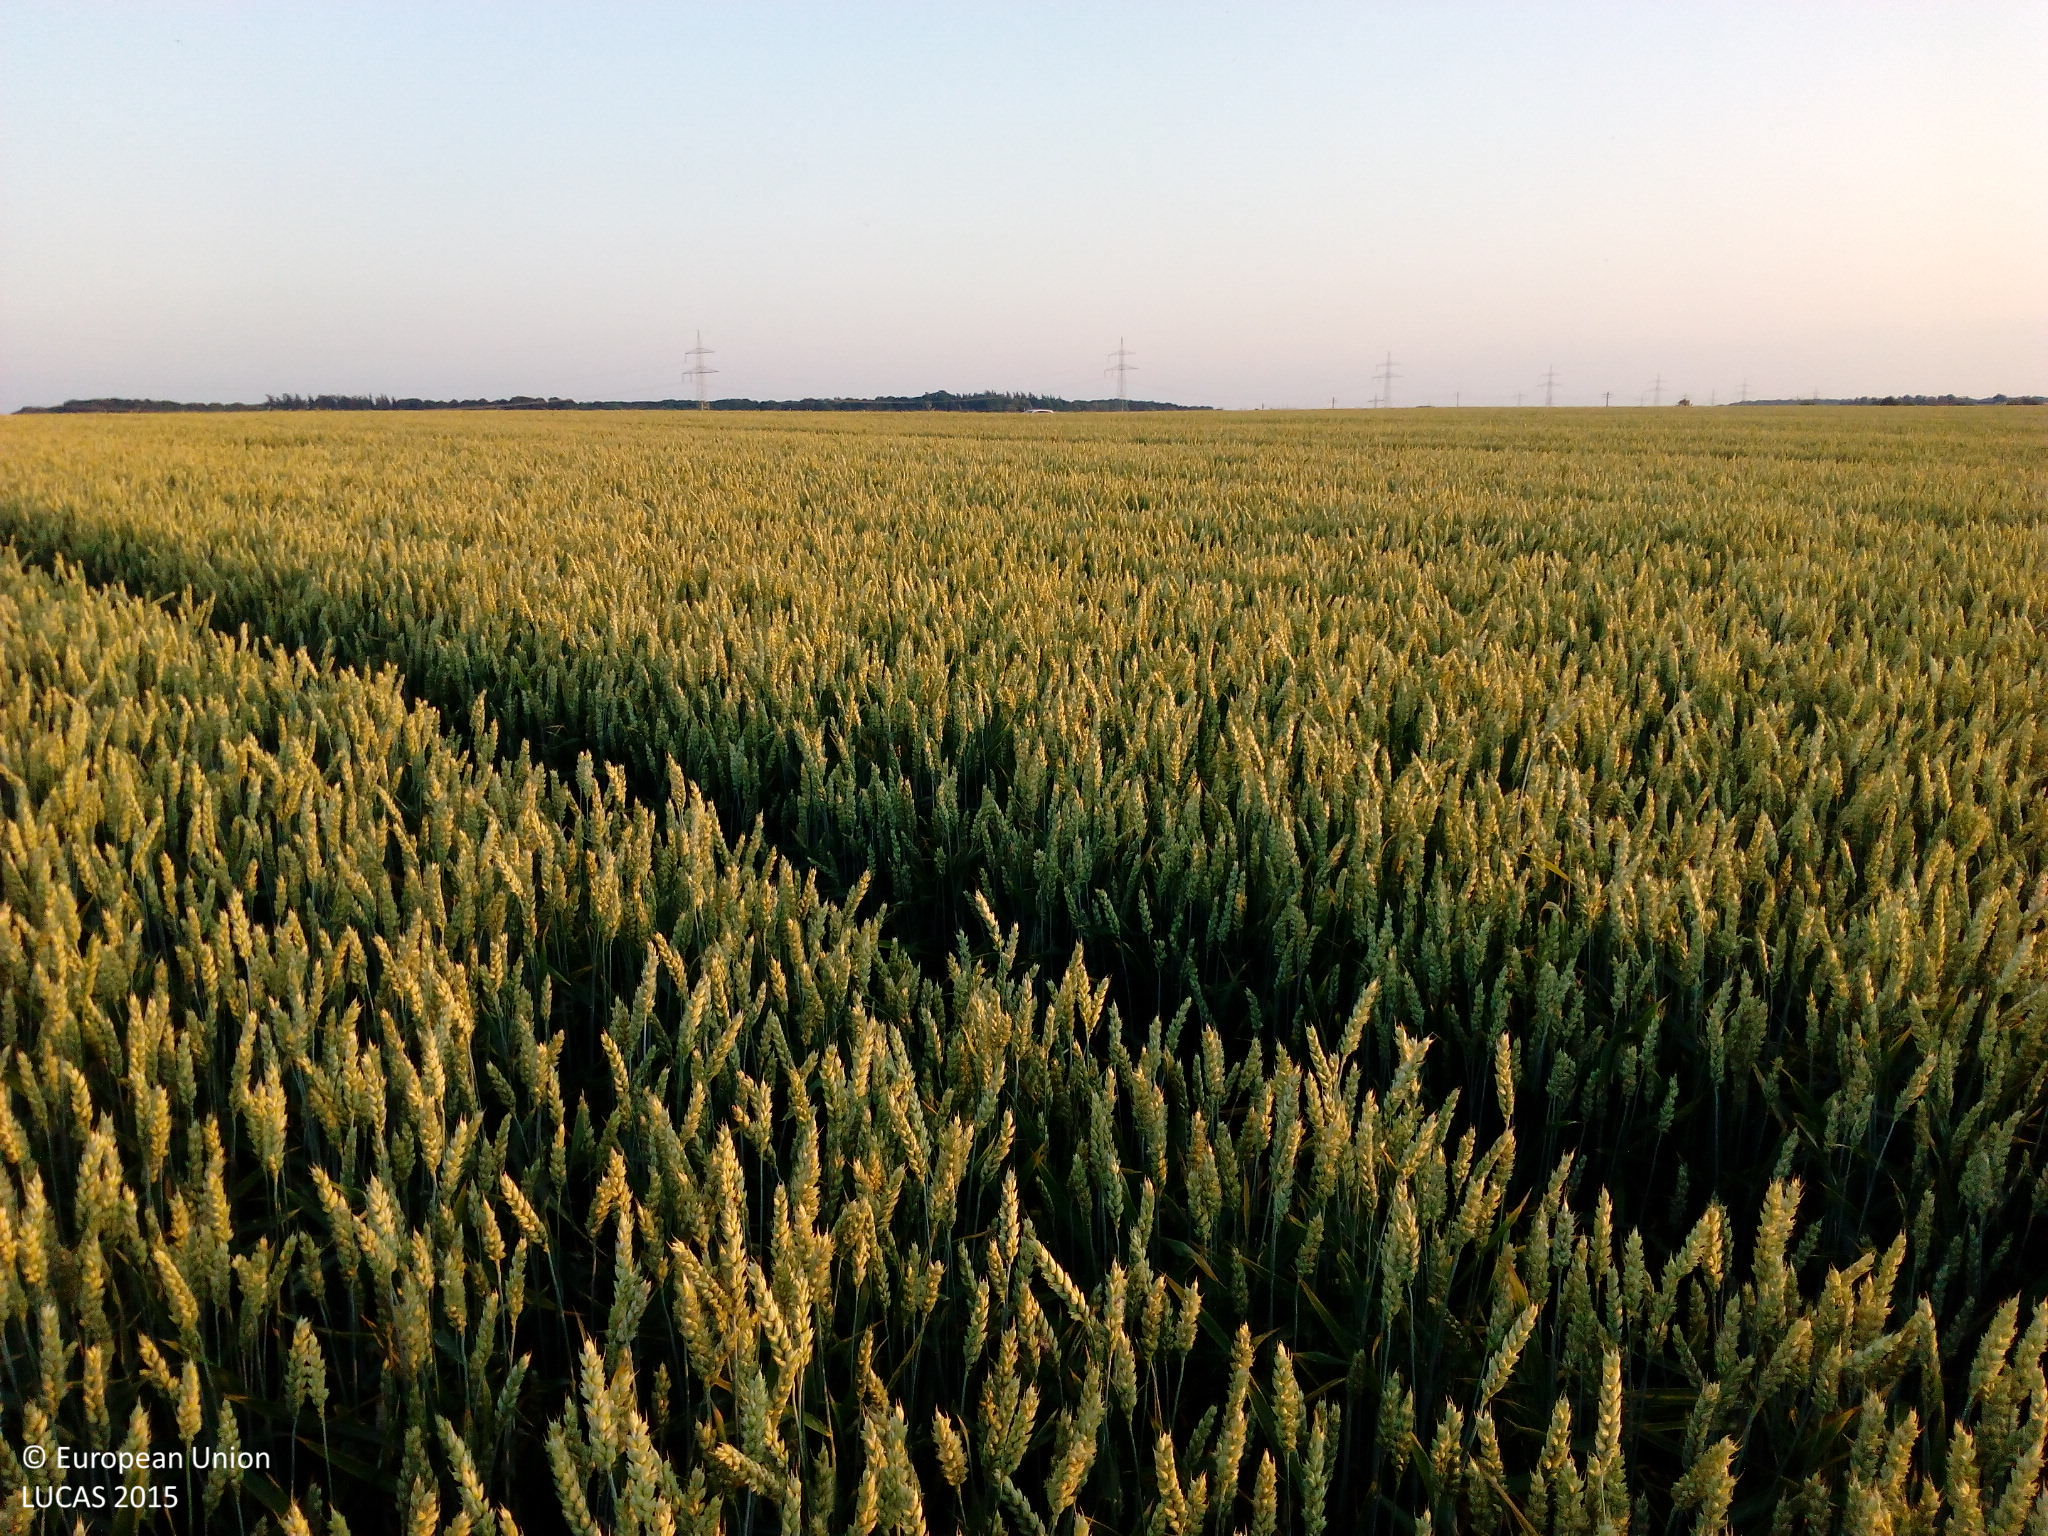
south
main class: Cropland
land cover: Common wheat
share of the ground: > 75 %
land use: Agriculture (excluding fallow land and kitchen gardens)
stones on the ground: < 10 %
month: July
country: DE
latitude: 49.5908
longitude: 9.9585
